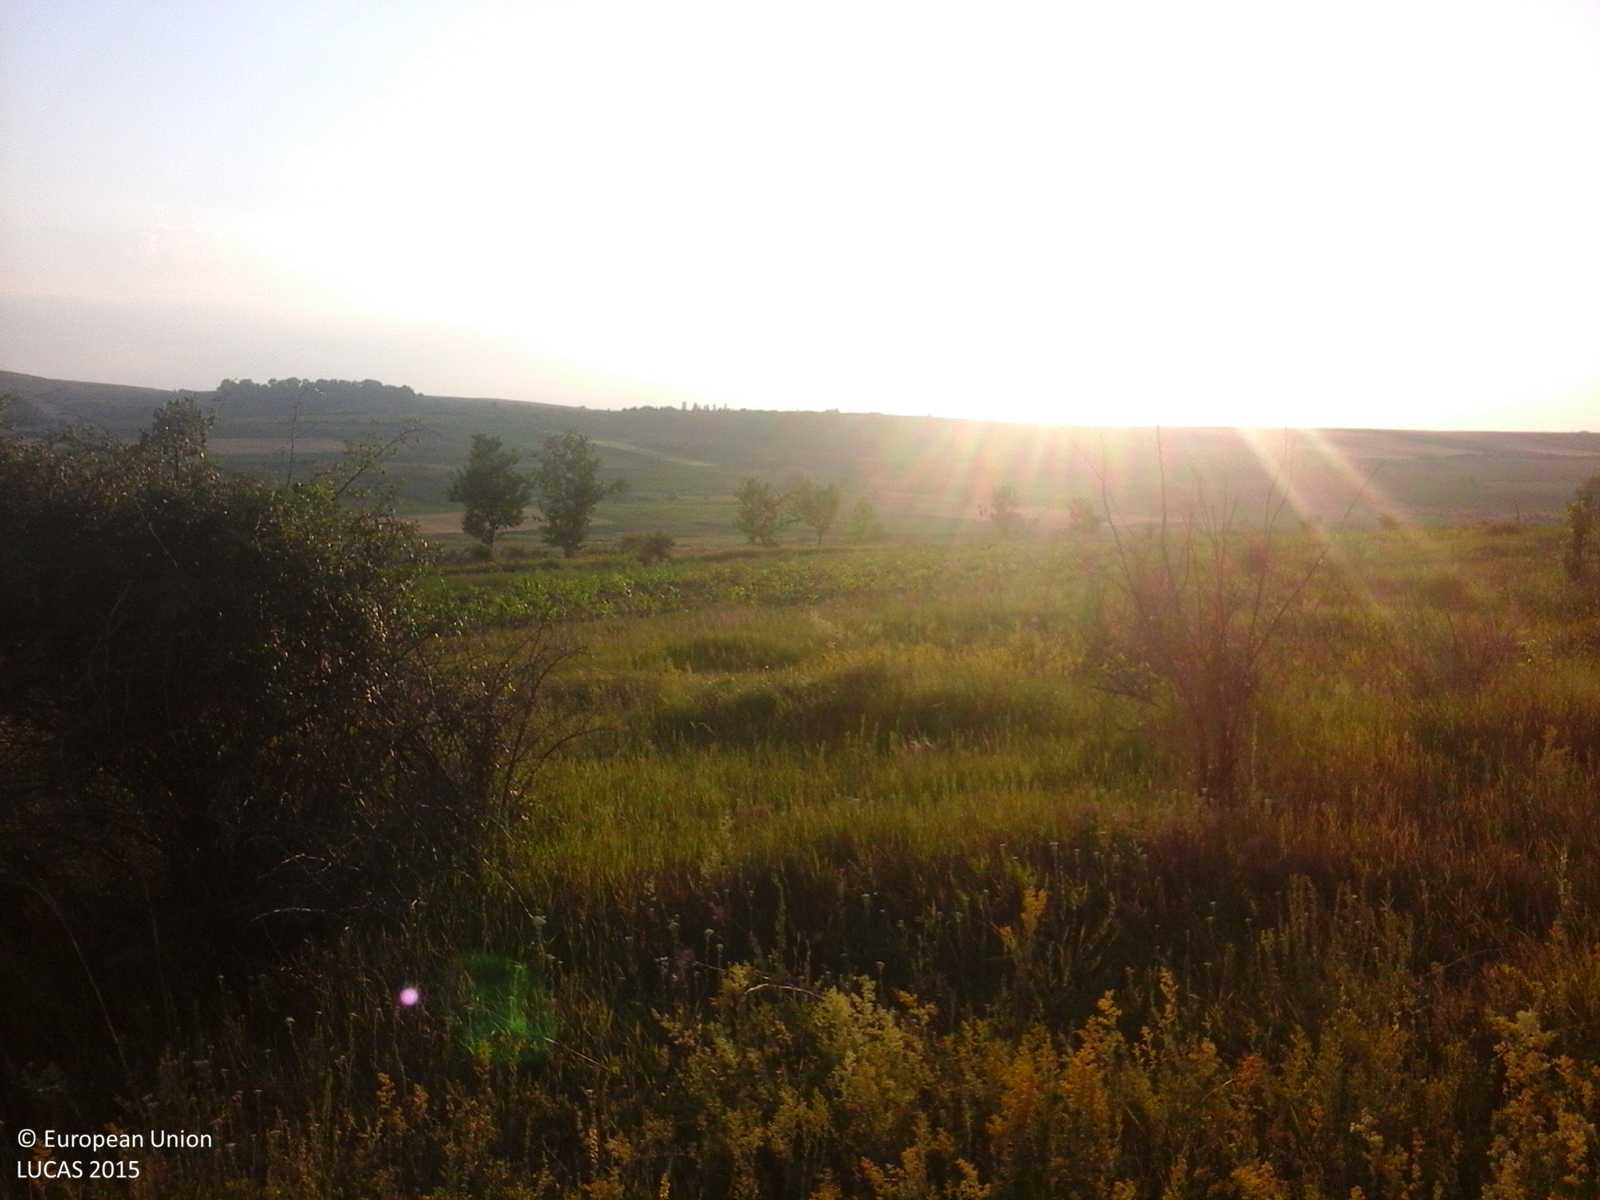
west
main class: Grassland
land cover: Grassland with sparse tree/shrub cover
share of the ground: > 75 %
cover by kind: herbaceous plants 85 %, shrubs 10 %, broadleaved forest trees 5 %
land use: Agriculture (excluding fallow land and kitchen gardens)
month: June
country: RO
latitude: 46.8636
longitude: 27.2781
